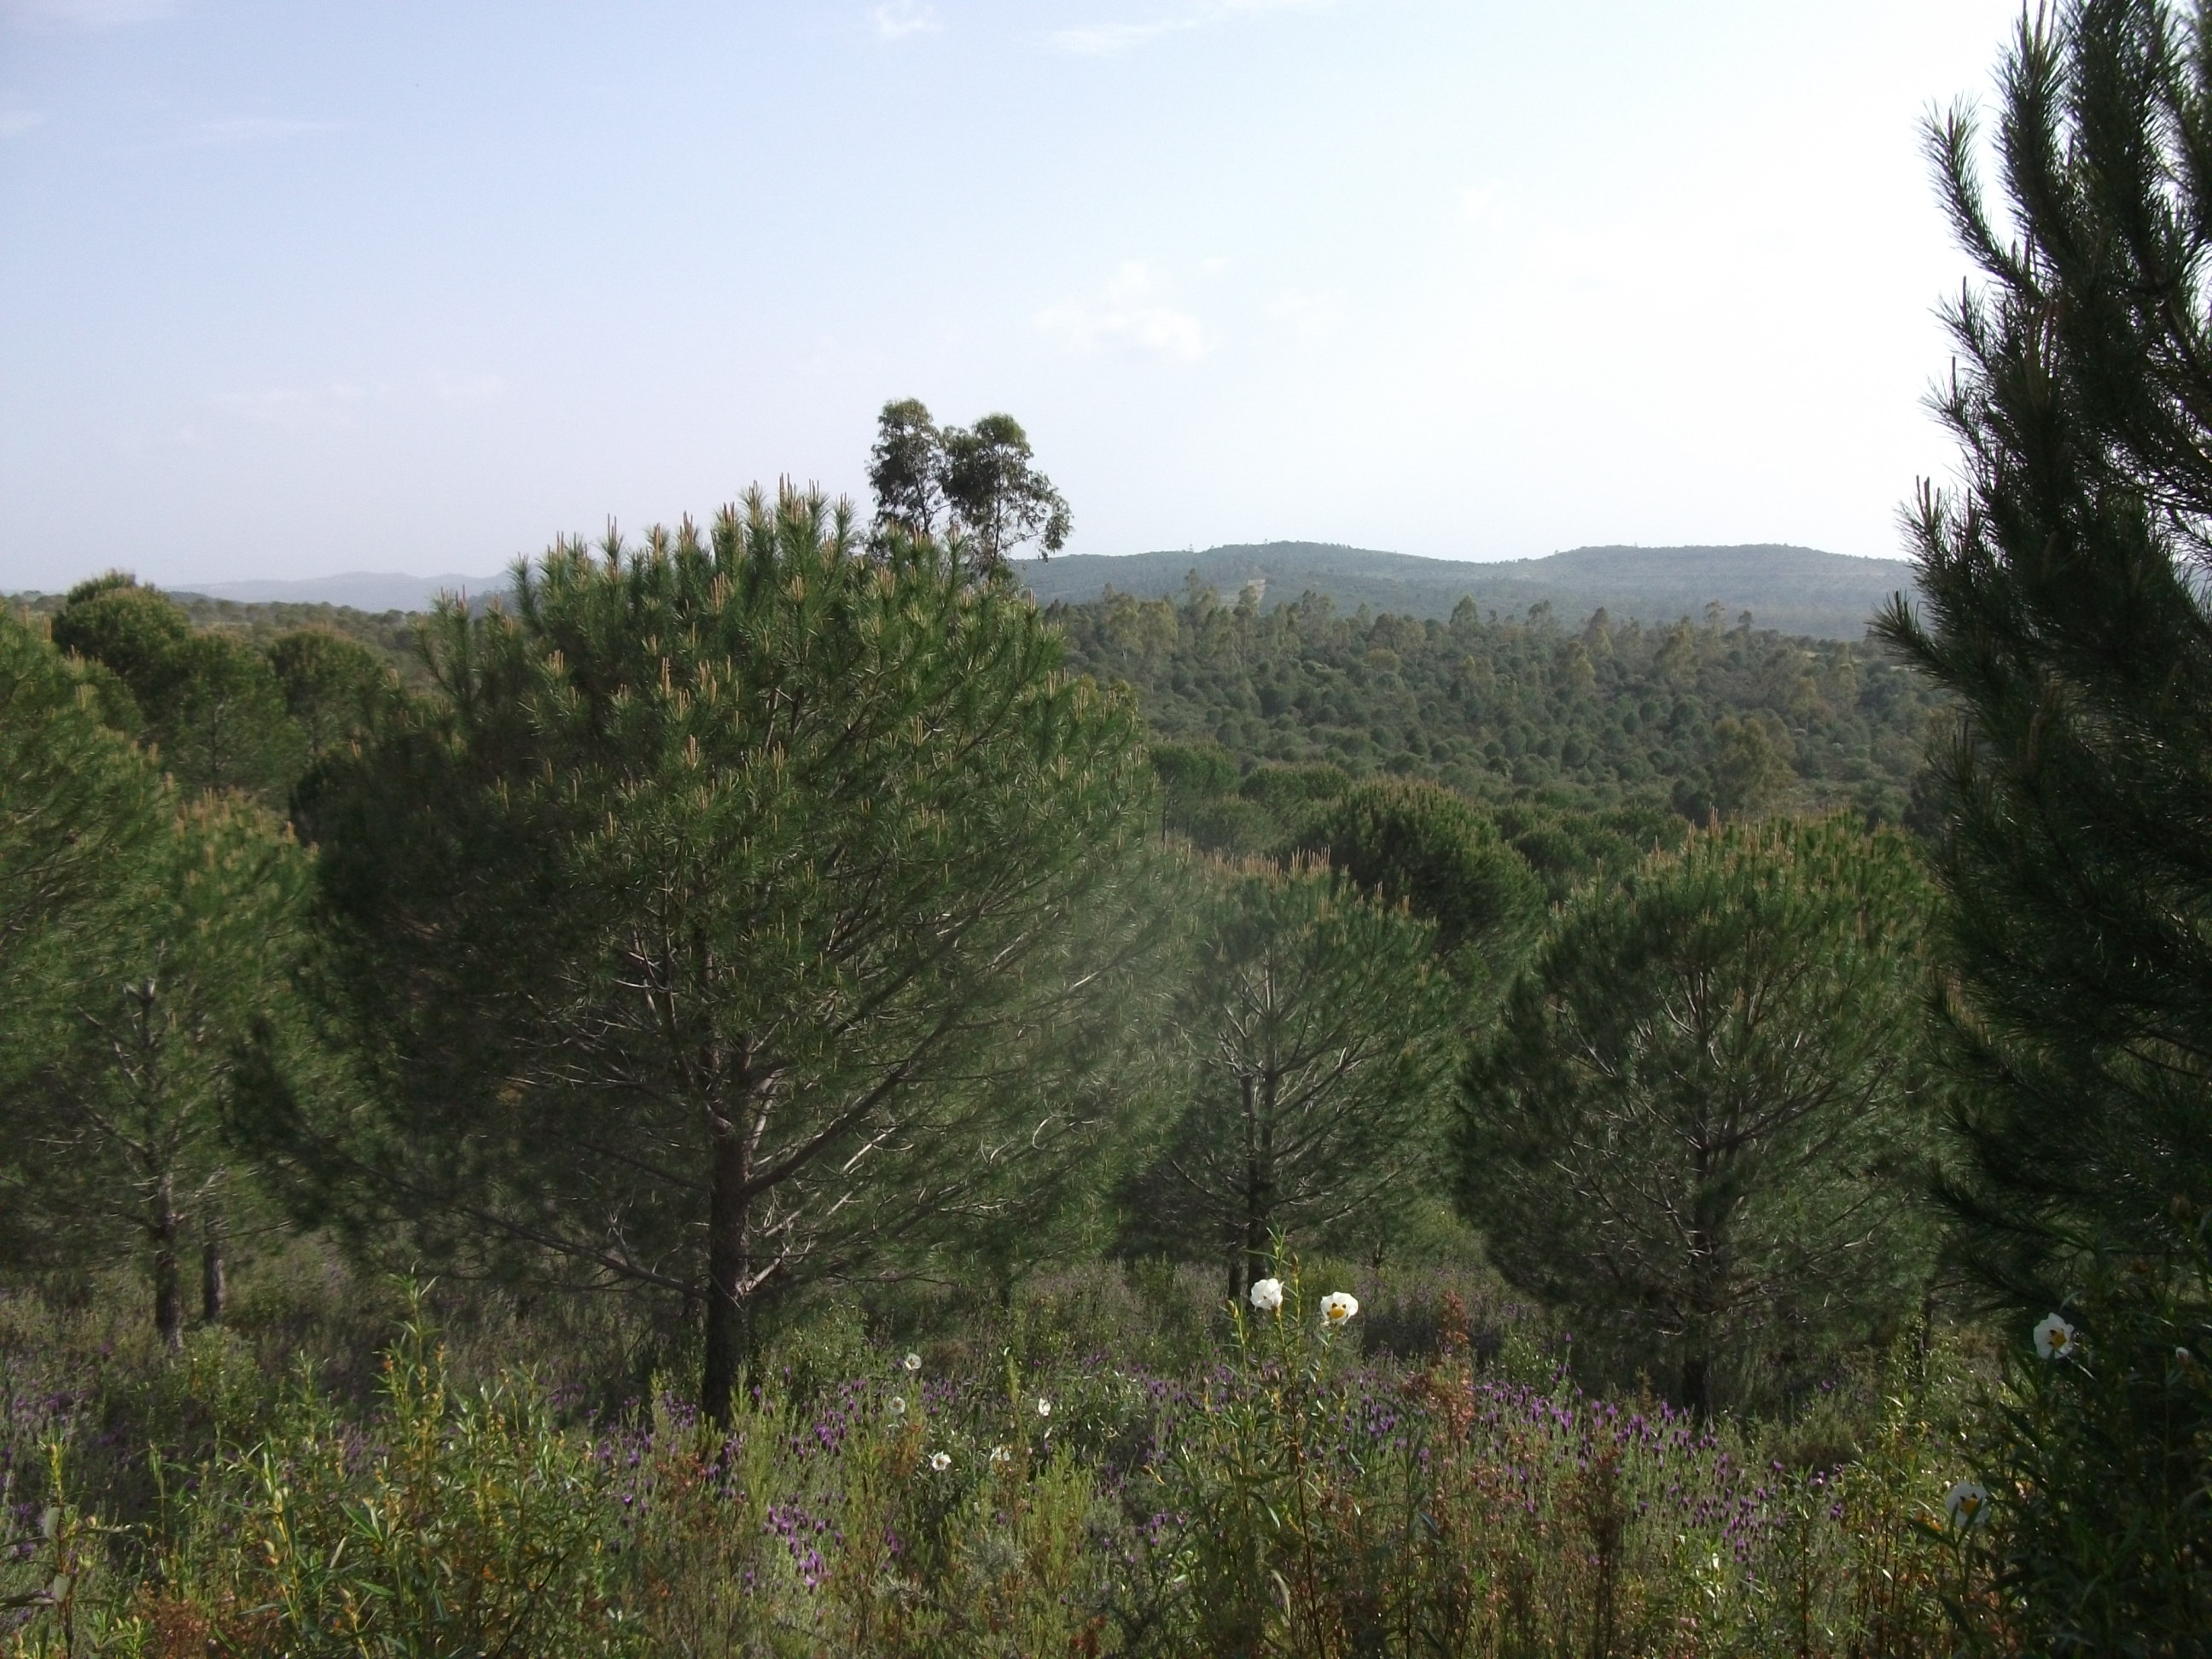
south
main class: Woodland
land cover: Pine dominated coniferous woodland
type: coniferous forest of the mediterranean region
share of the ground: 50 - 75 %
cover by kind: coniferous forest trees 70 %, shrubs 30 %
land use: Forestry
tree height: > 5 m
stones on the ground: 10 - 25 %
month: April
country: ES
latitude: 37.7952
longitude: -6.6809
